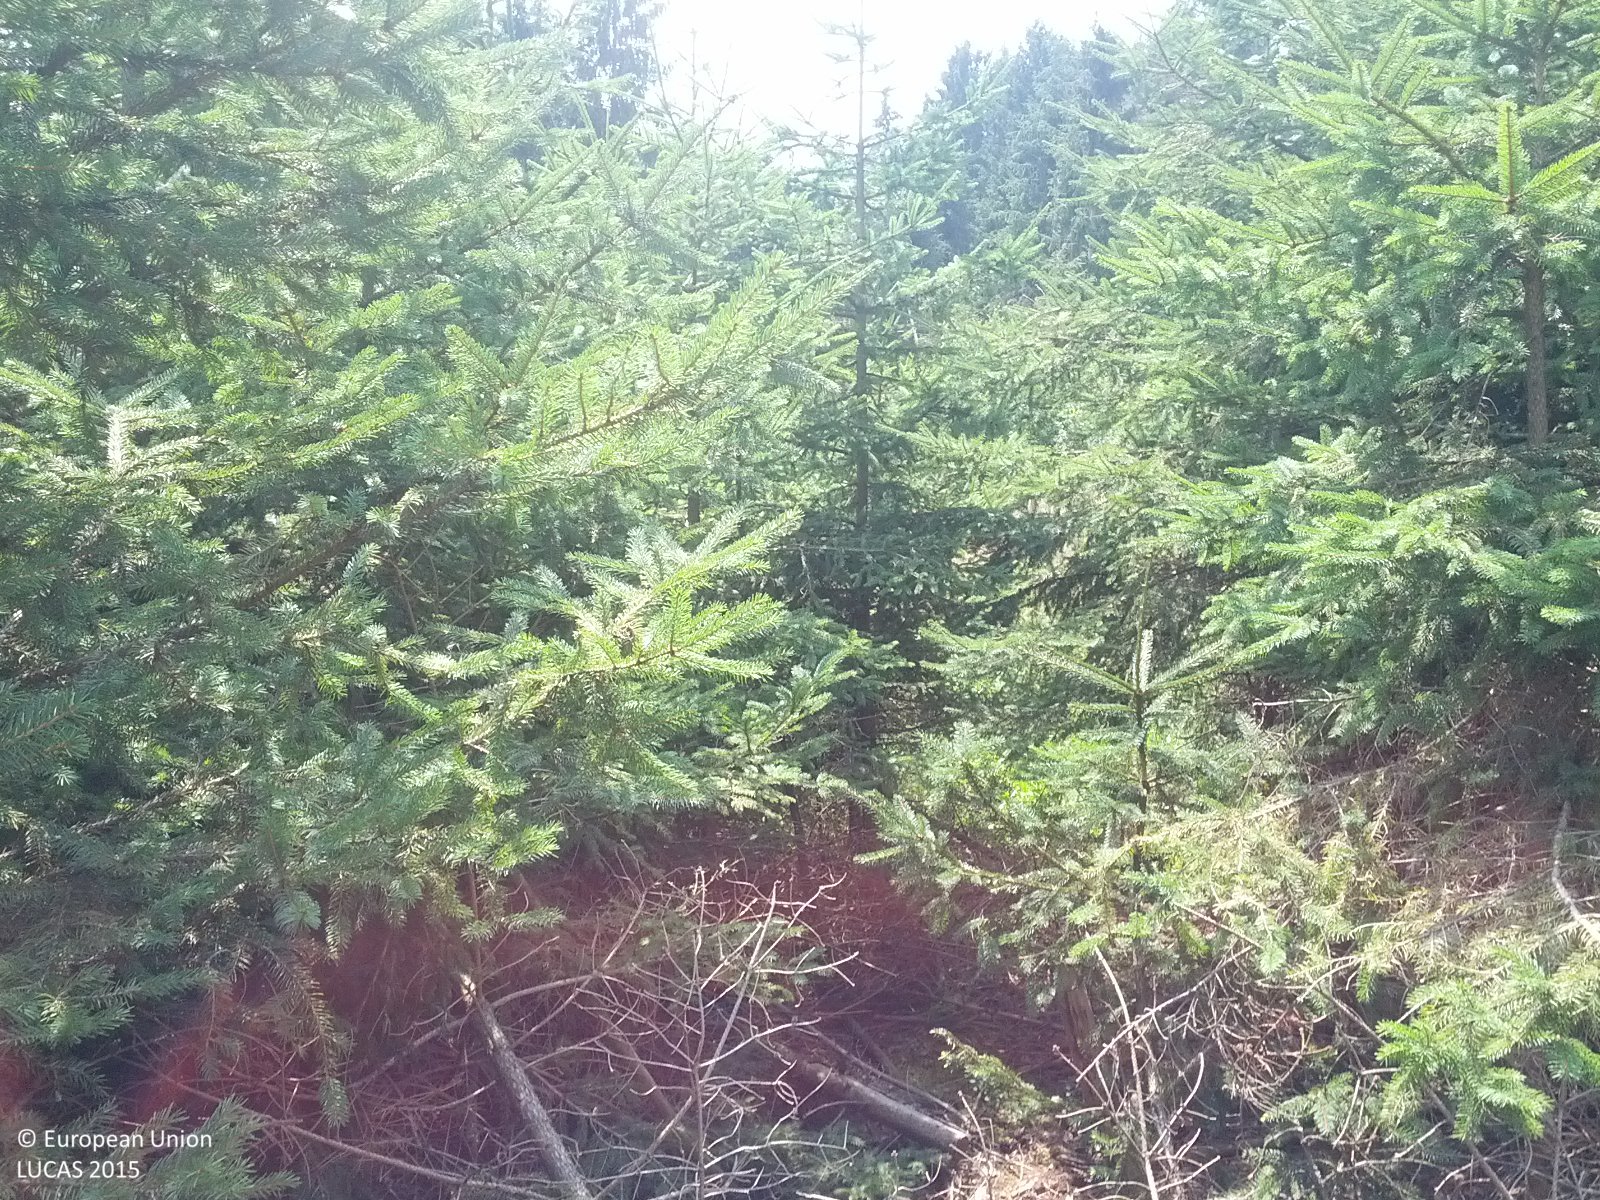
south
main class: Woodland
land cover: Spruce dominated coniferous woodland
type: alpine coniferous forest
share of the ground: > 75 %
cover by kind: coniferous forest trees 80 %, herbaceous plants 10 %, unconsolidated bare surface 10 %
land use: Forestry
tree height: > 5 m
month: July
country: AT
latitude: 47.2399
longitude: 16.1448
